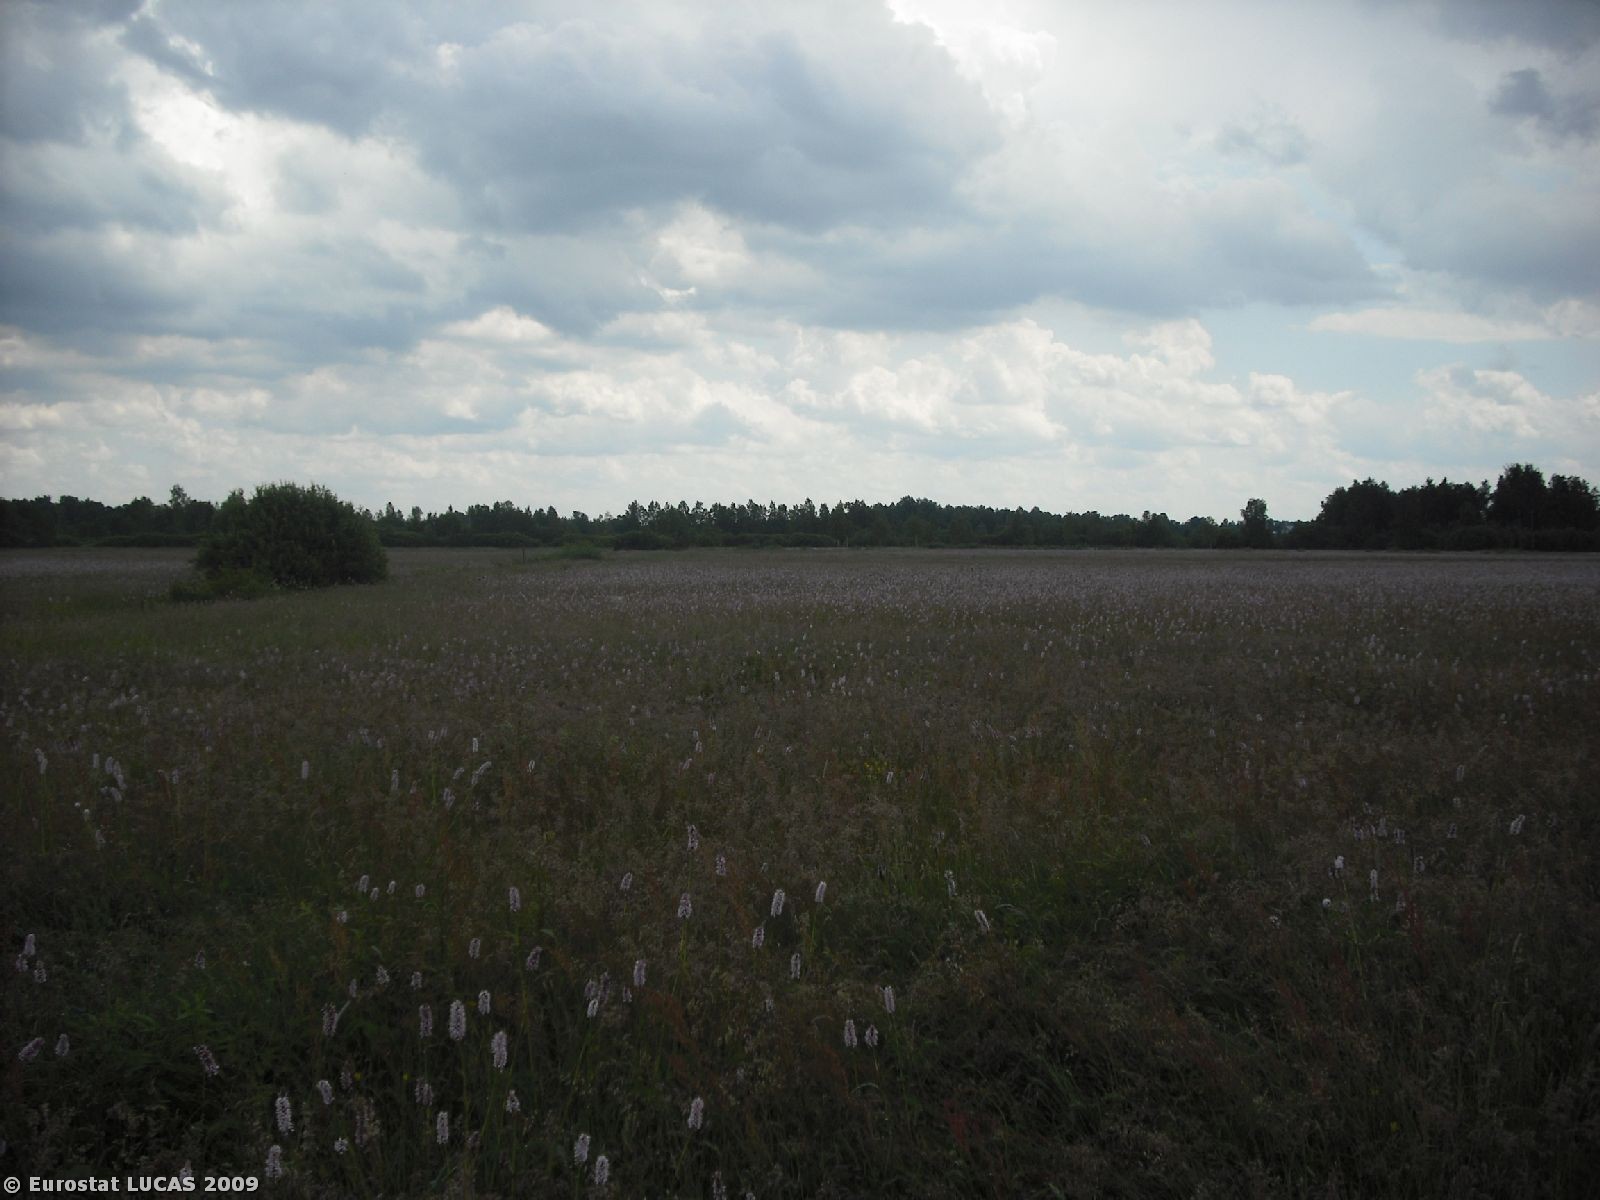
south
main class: Grassland
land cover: Grassland without tree/shrub cover
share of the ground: > 75 %
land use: Agriculture (excluding fallow land and kitchen gardens)
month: June
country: PL
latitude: 53.6975
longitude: 23.5182
